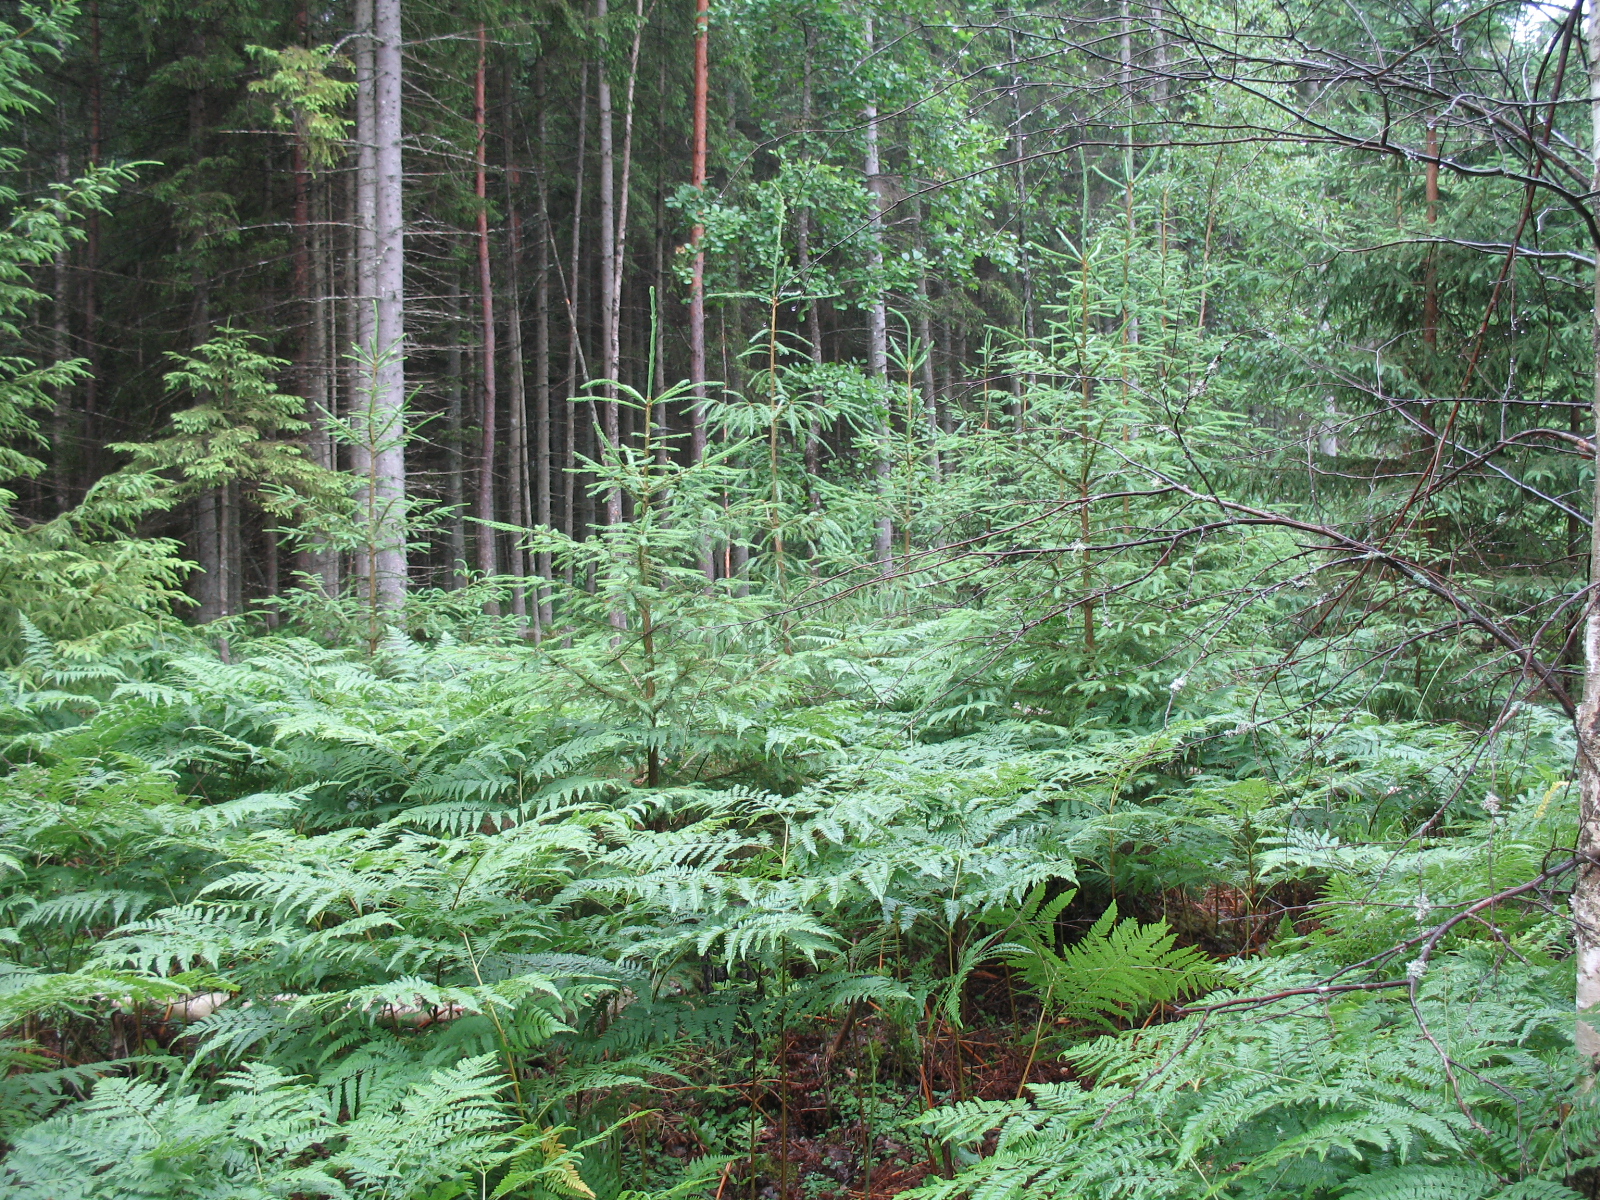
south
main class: Woodland
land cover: Spruce dominated mixed woodland
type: hemiboreal forest and nemoral coniferous forest and mixed broadleaved-coniferous forest
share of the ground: 50 - 75 %
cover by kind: broadleaved forest trees 40 %, herbaceous plants 40 %, coniferous forest trees 20 %
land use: Forestry
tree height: > 5 m
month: July
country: LV
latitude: 56.7354
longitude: 23.7948
